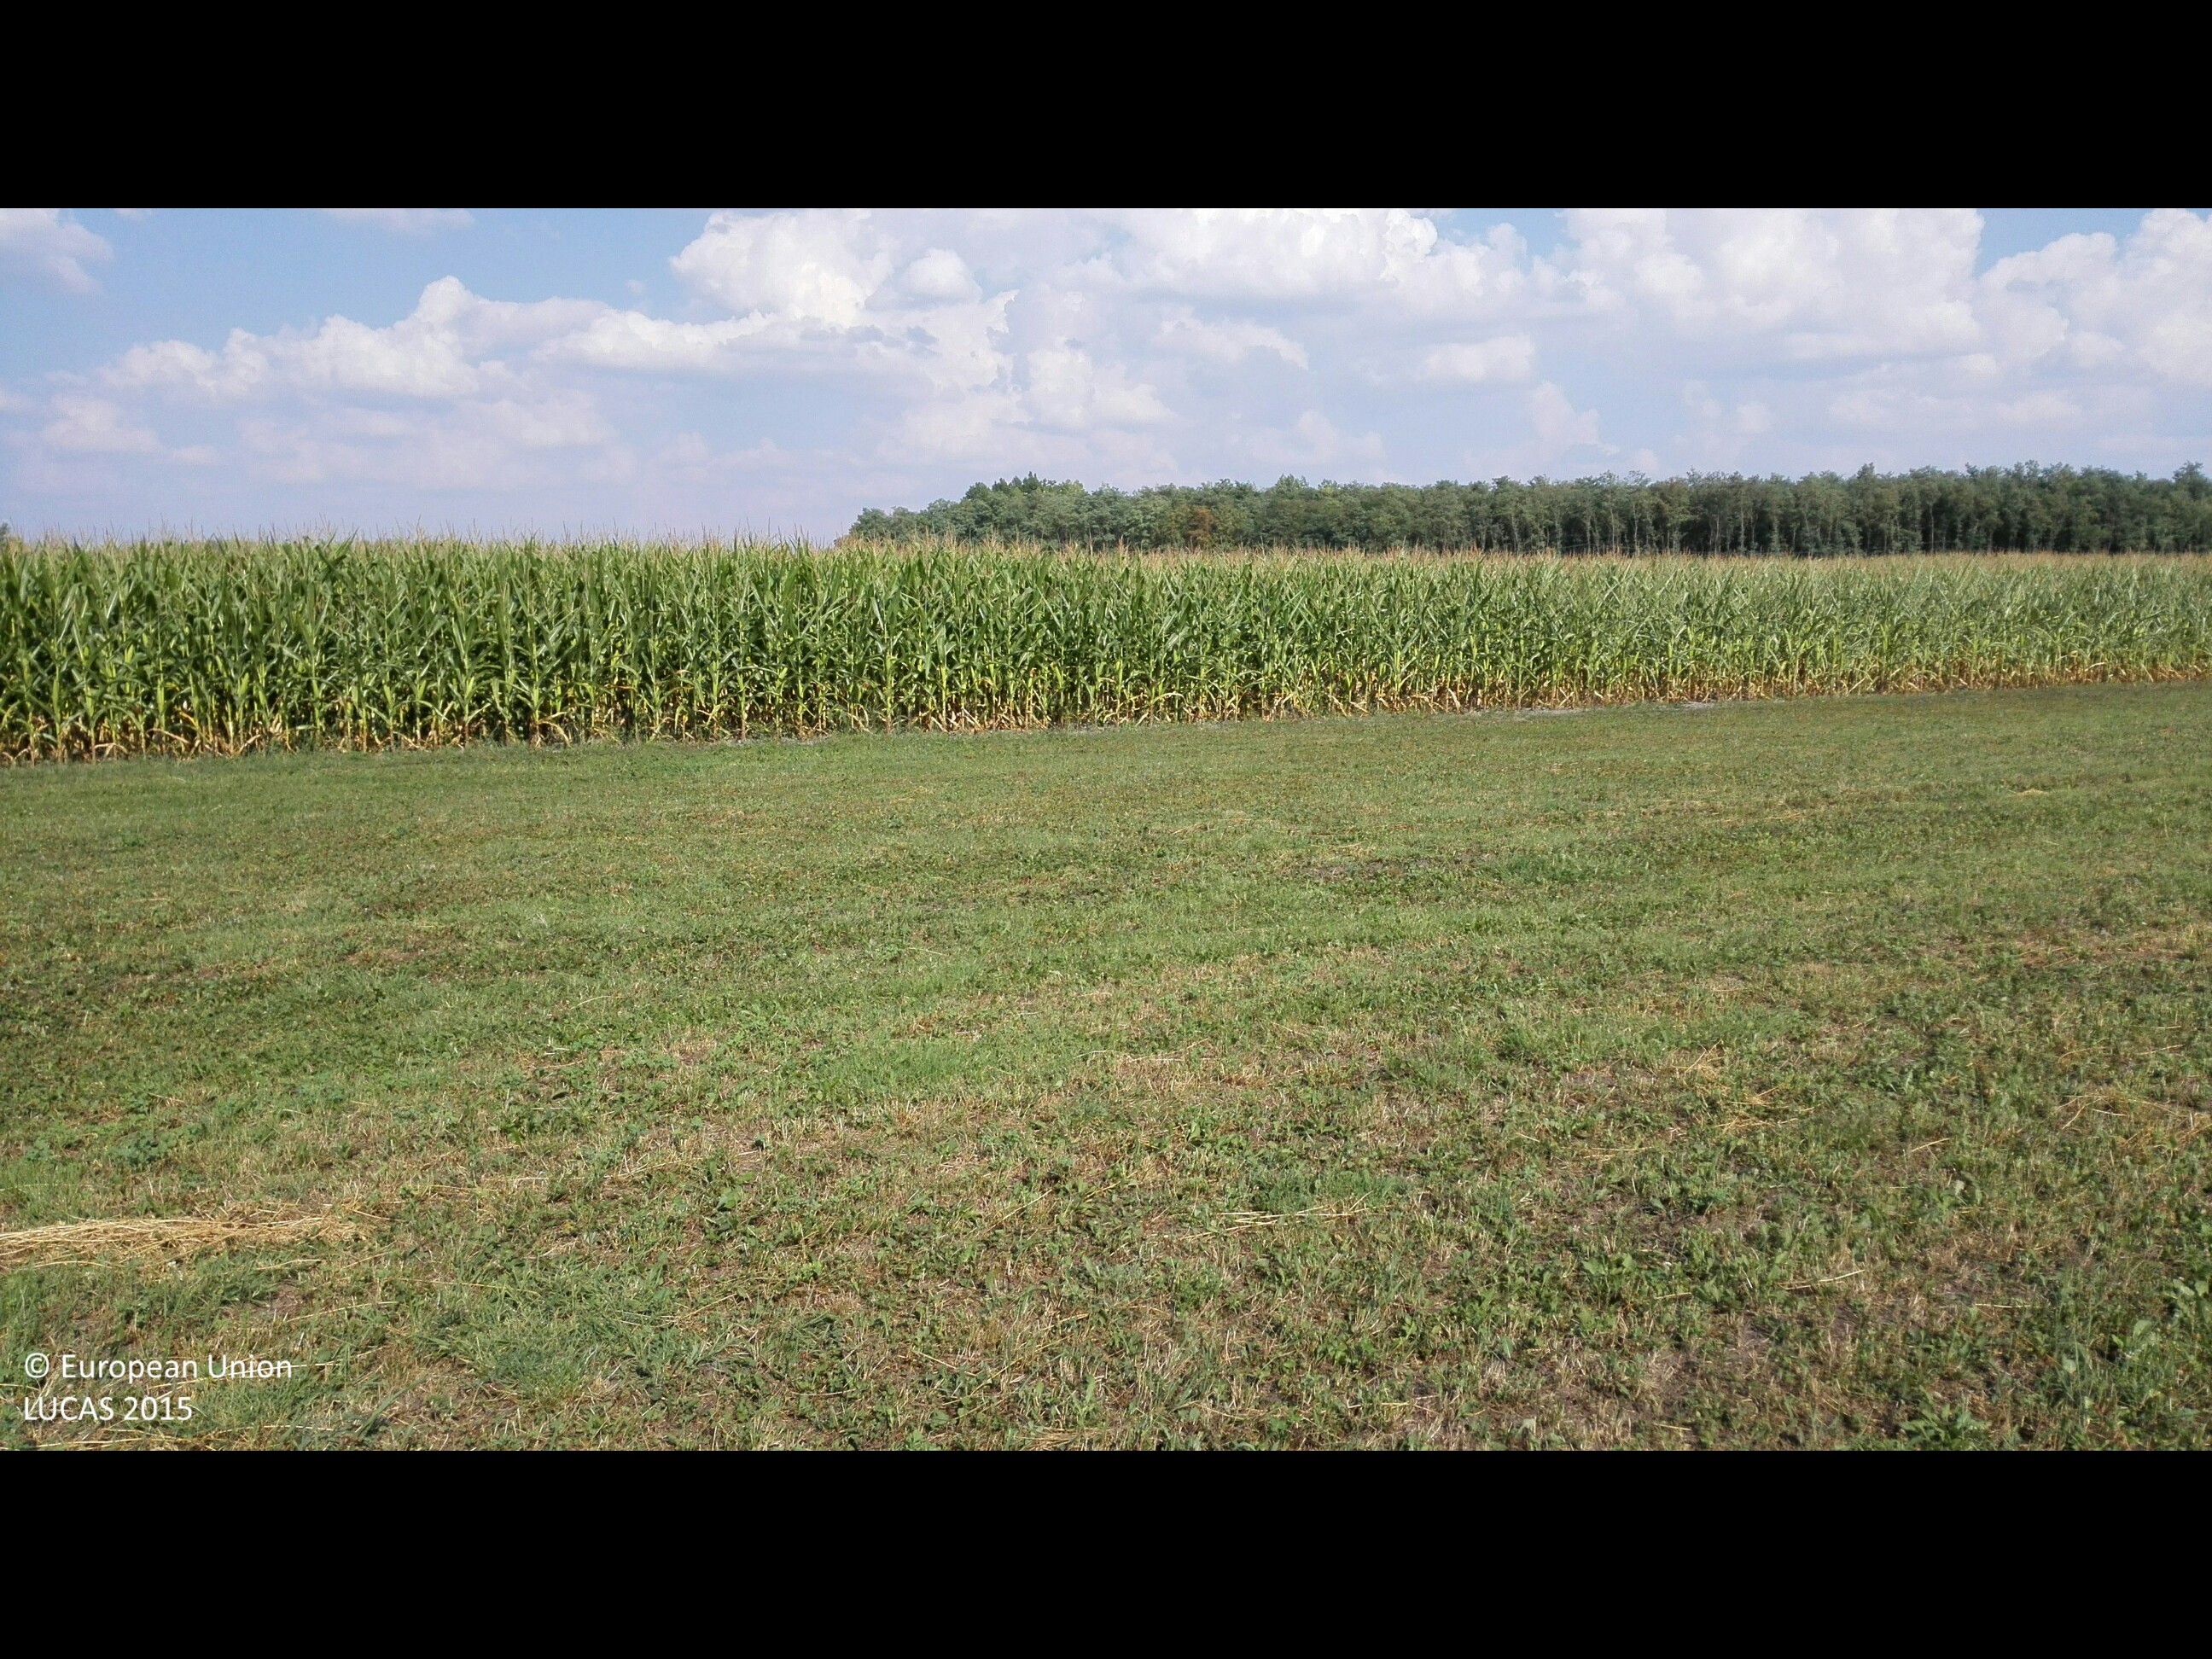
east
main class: Cropland
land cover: Lucerne
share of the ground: > 75 %
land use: Agriculture (excluding fallow land and kitchen gardens)
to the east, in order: Lucerne; Maize; Lucerne; Electric lines; Lucerne
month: August
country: HU
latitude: 47.5089
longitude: 21.8512
